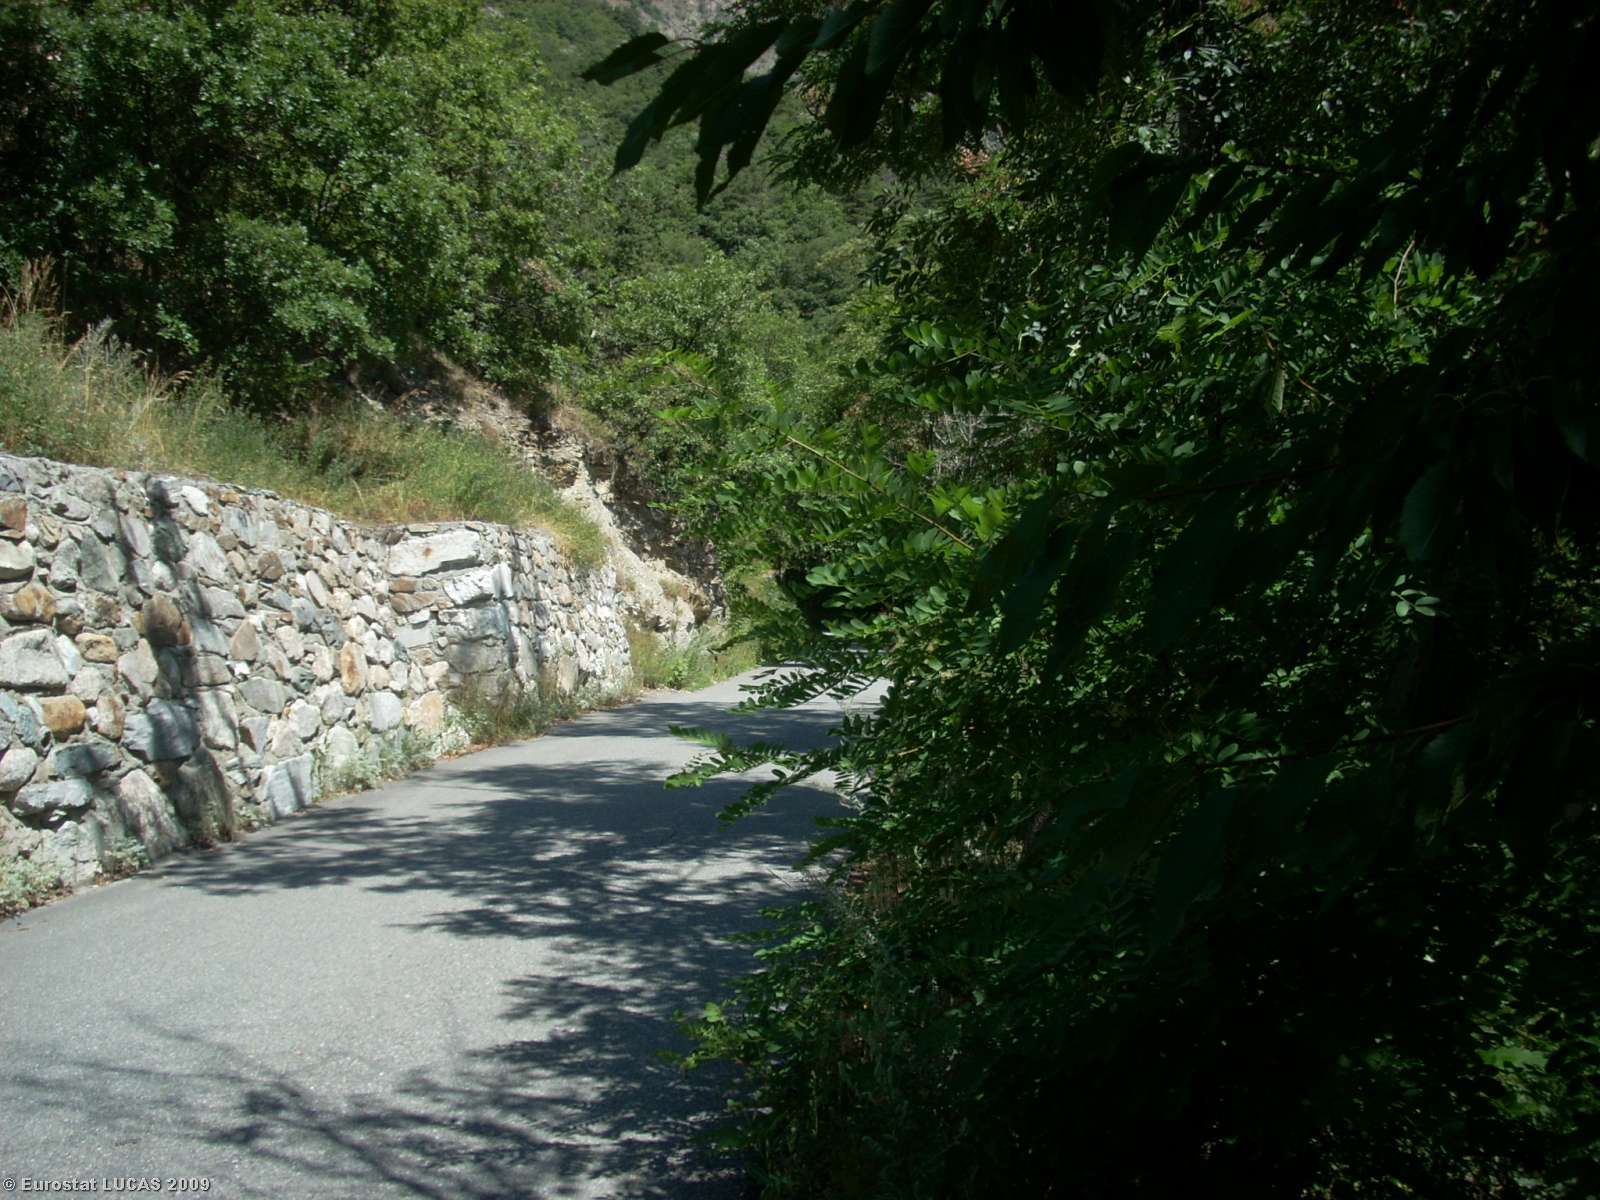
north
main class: Woodland
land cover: Mixed woodland
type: mesophytic deciduous forest
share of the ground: > 75 %
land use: Forestry
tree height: > 5 m
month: July
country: IT
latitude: 45.7601
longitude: 7.3679
